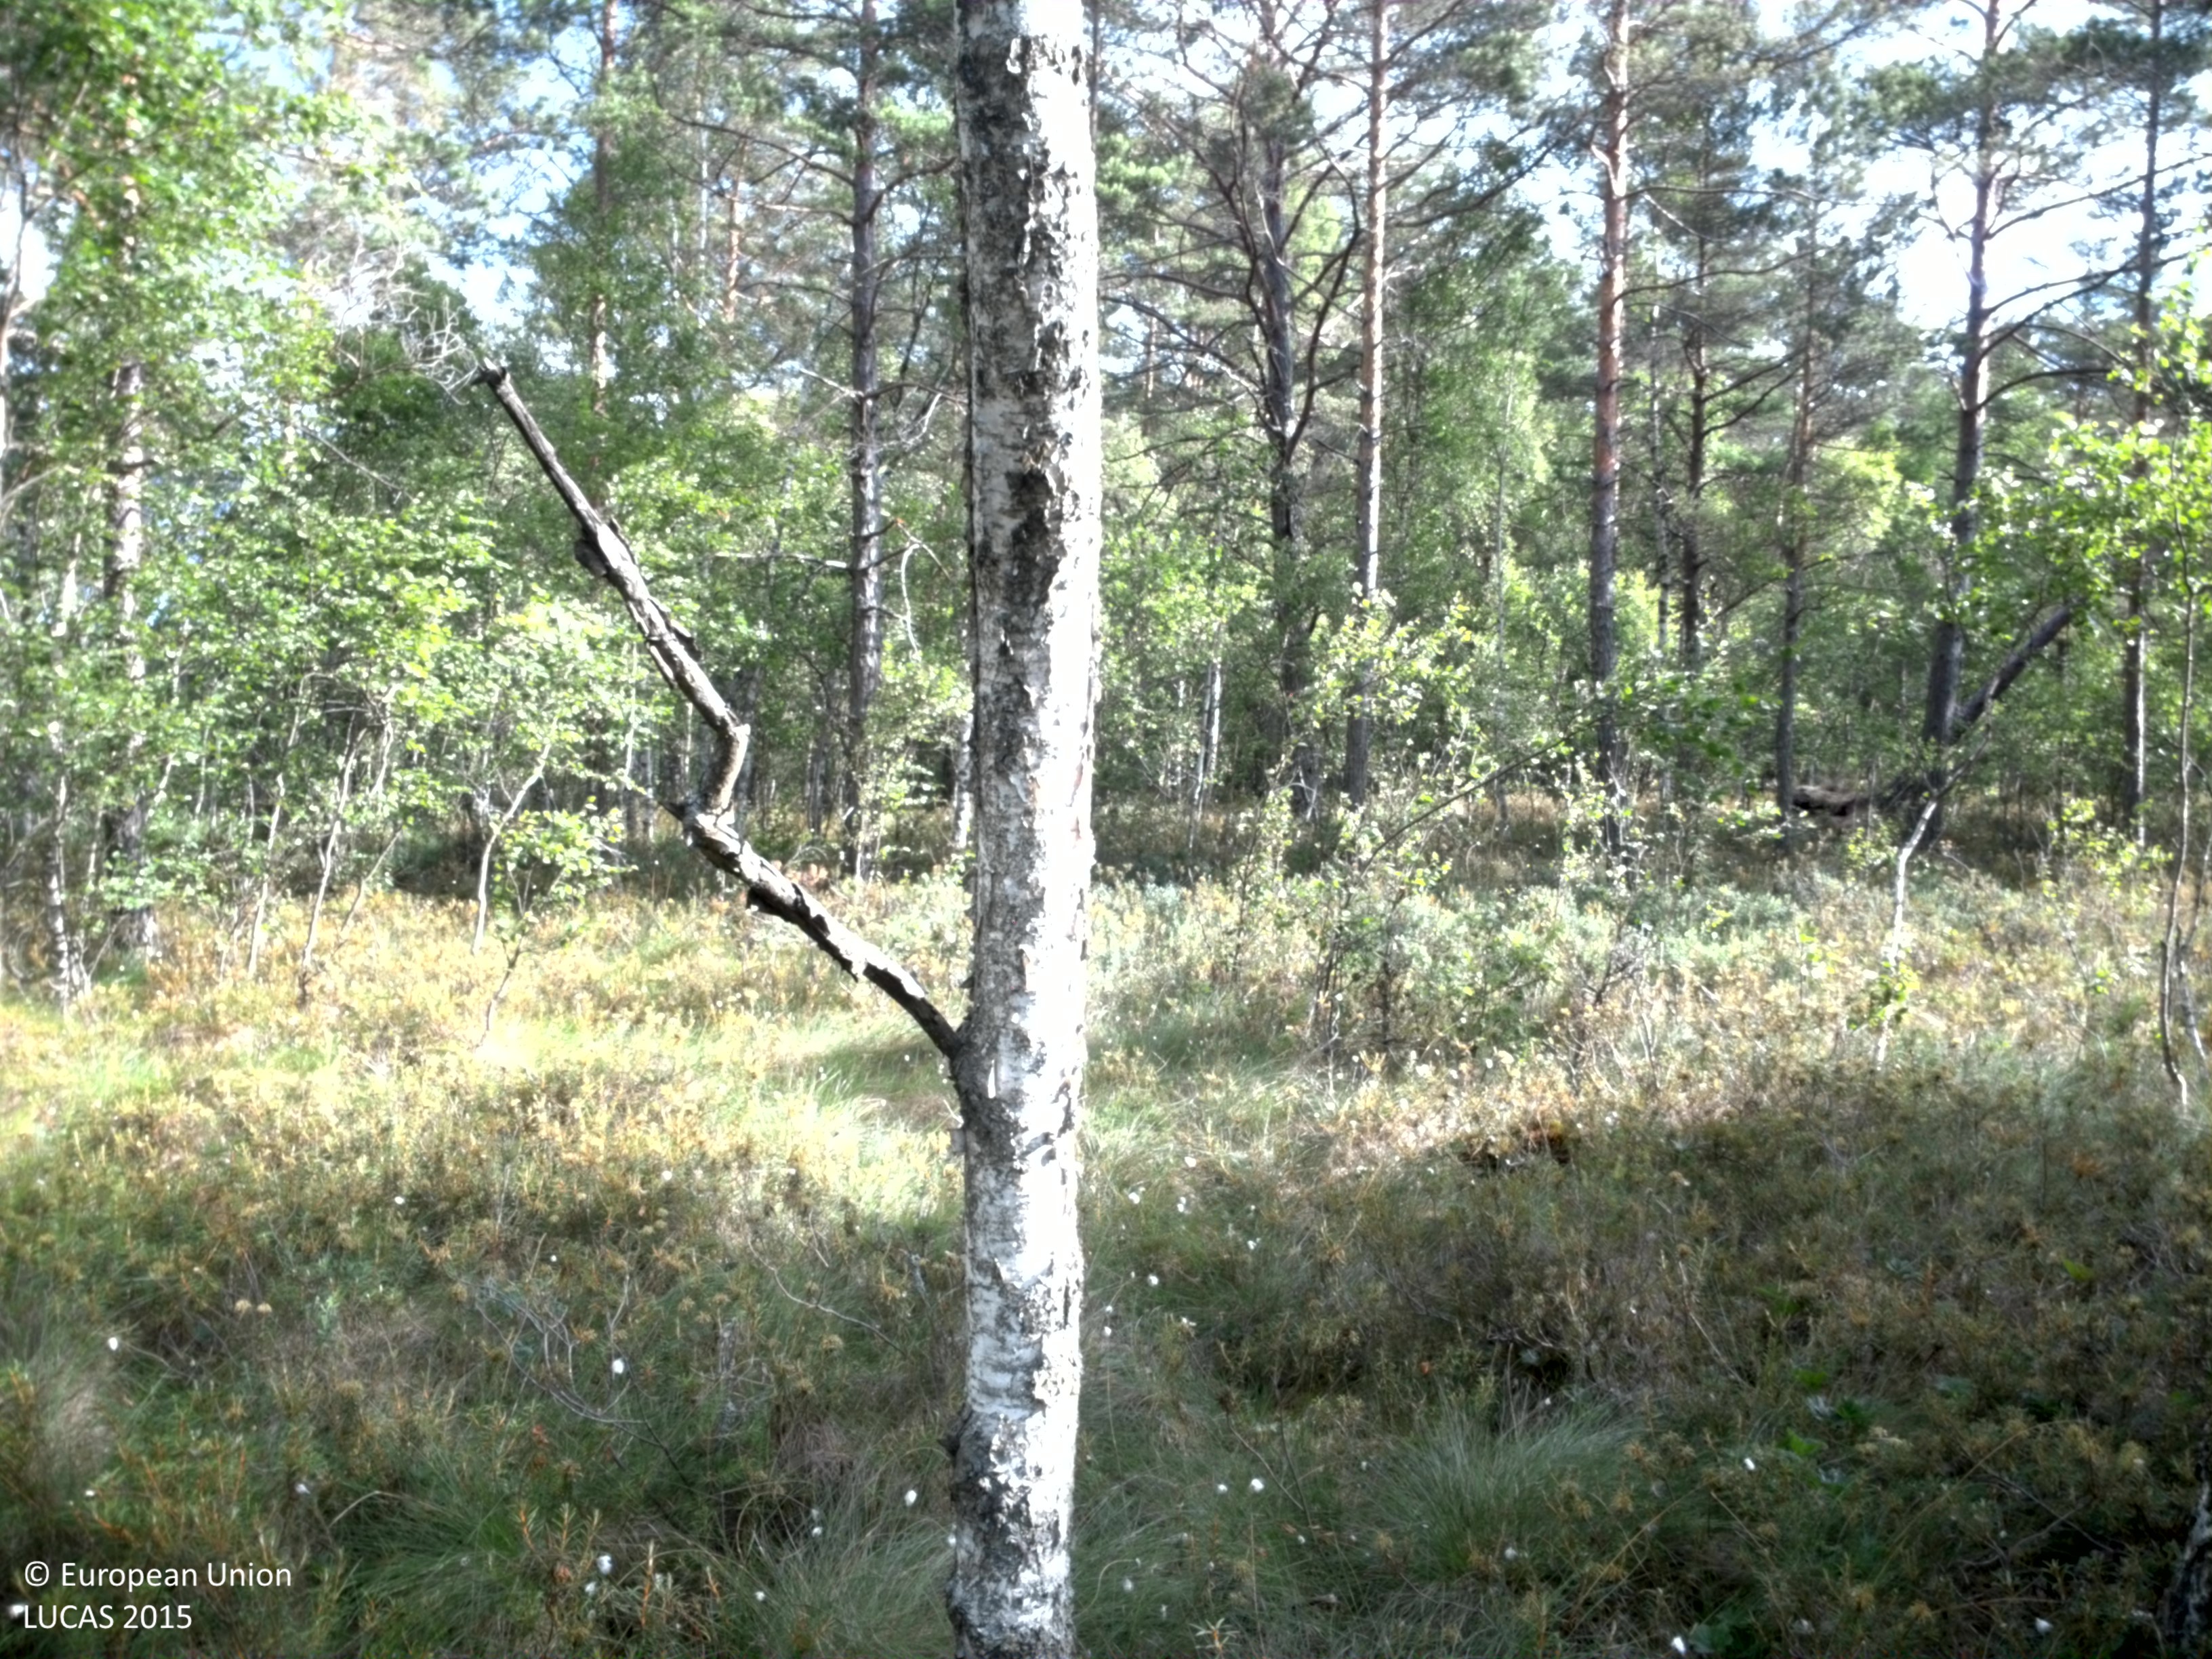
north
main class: Woodland
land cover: Pine dominated mixed woodland
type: boreal forest
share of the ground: 50 - 75 %
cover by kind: coniferous forest trees 35 %, broadleaved forest trees 25 %, shrubs 25 %, lichens and mosses 15 %
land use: Forestry
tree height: > 5 m
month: July
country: SE
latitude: 58.3579
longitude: 14.0100
